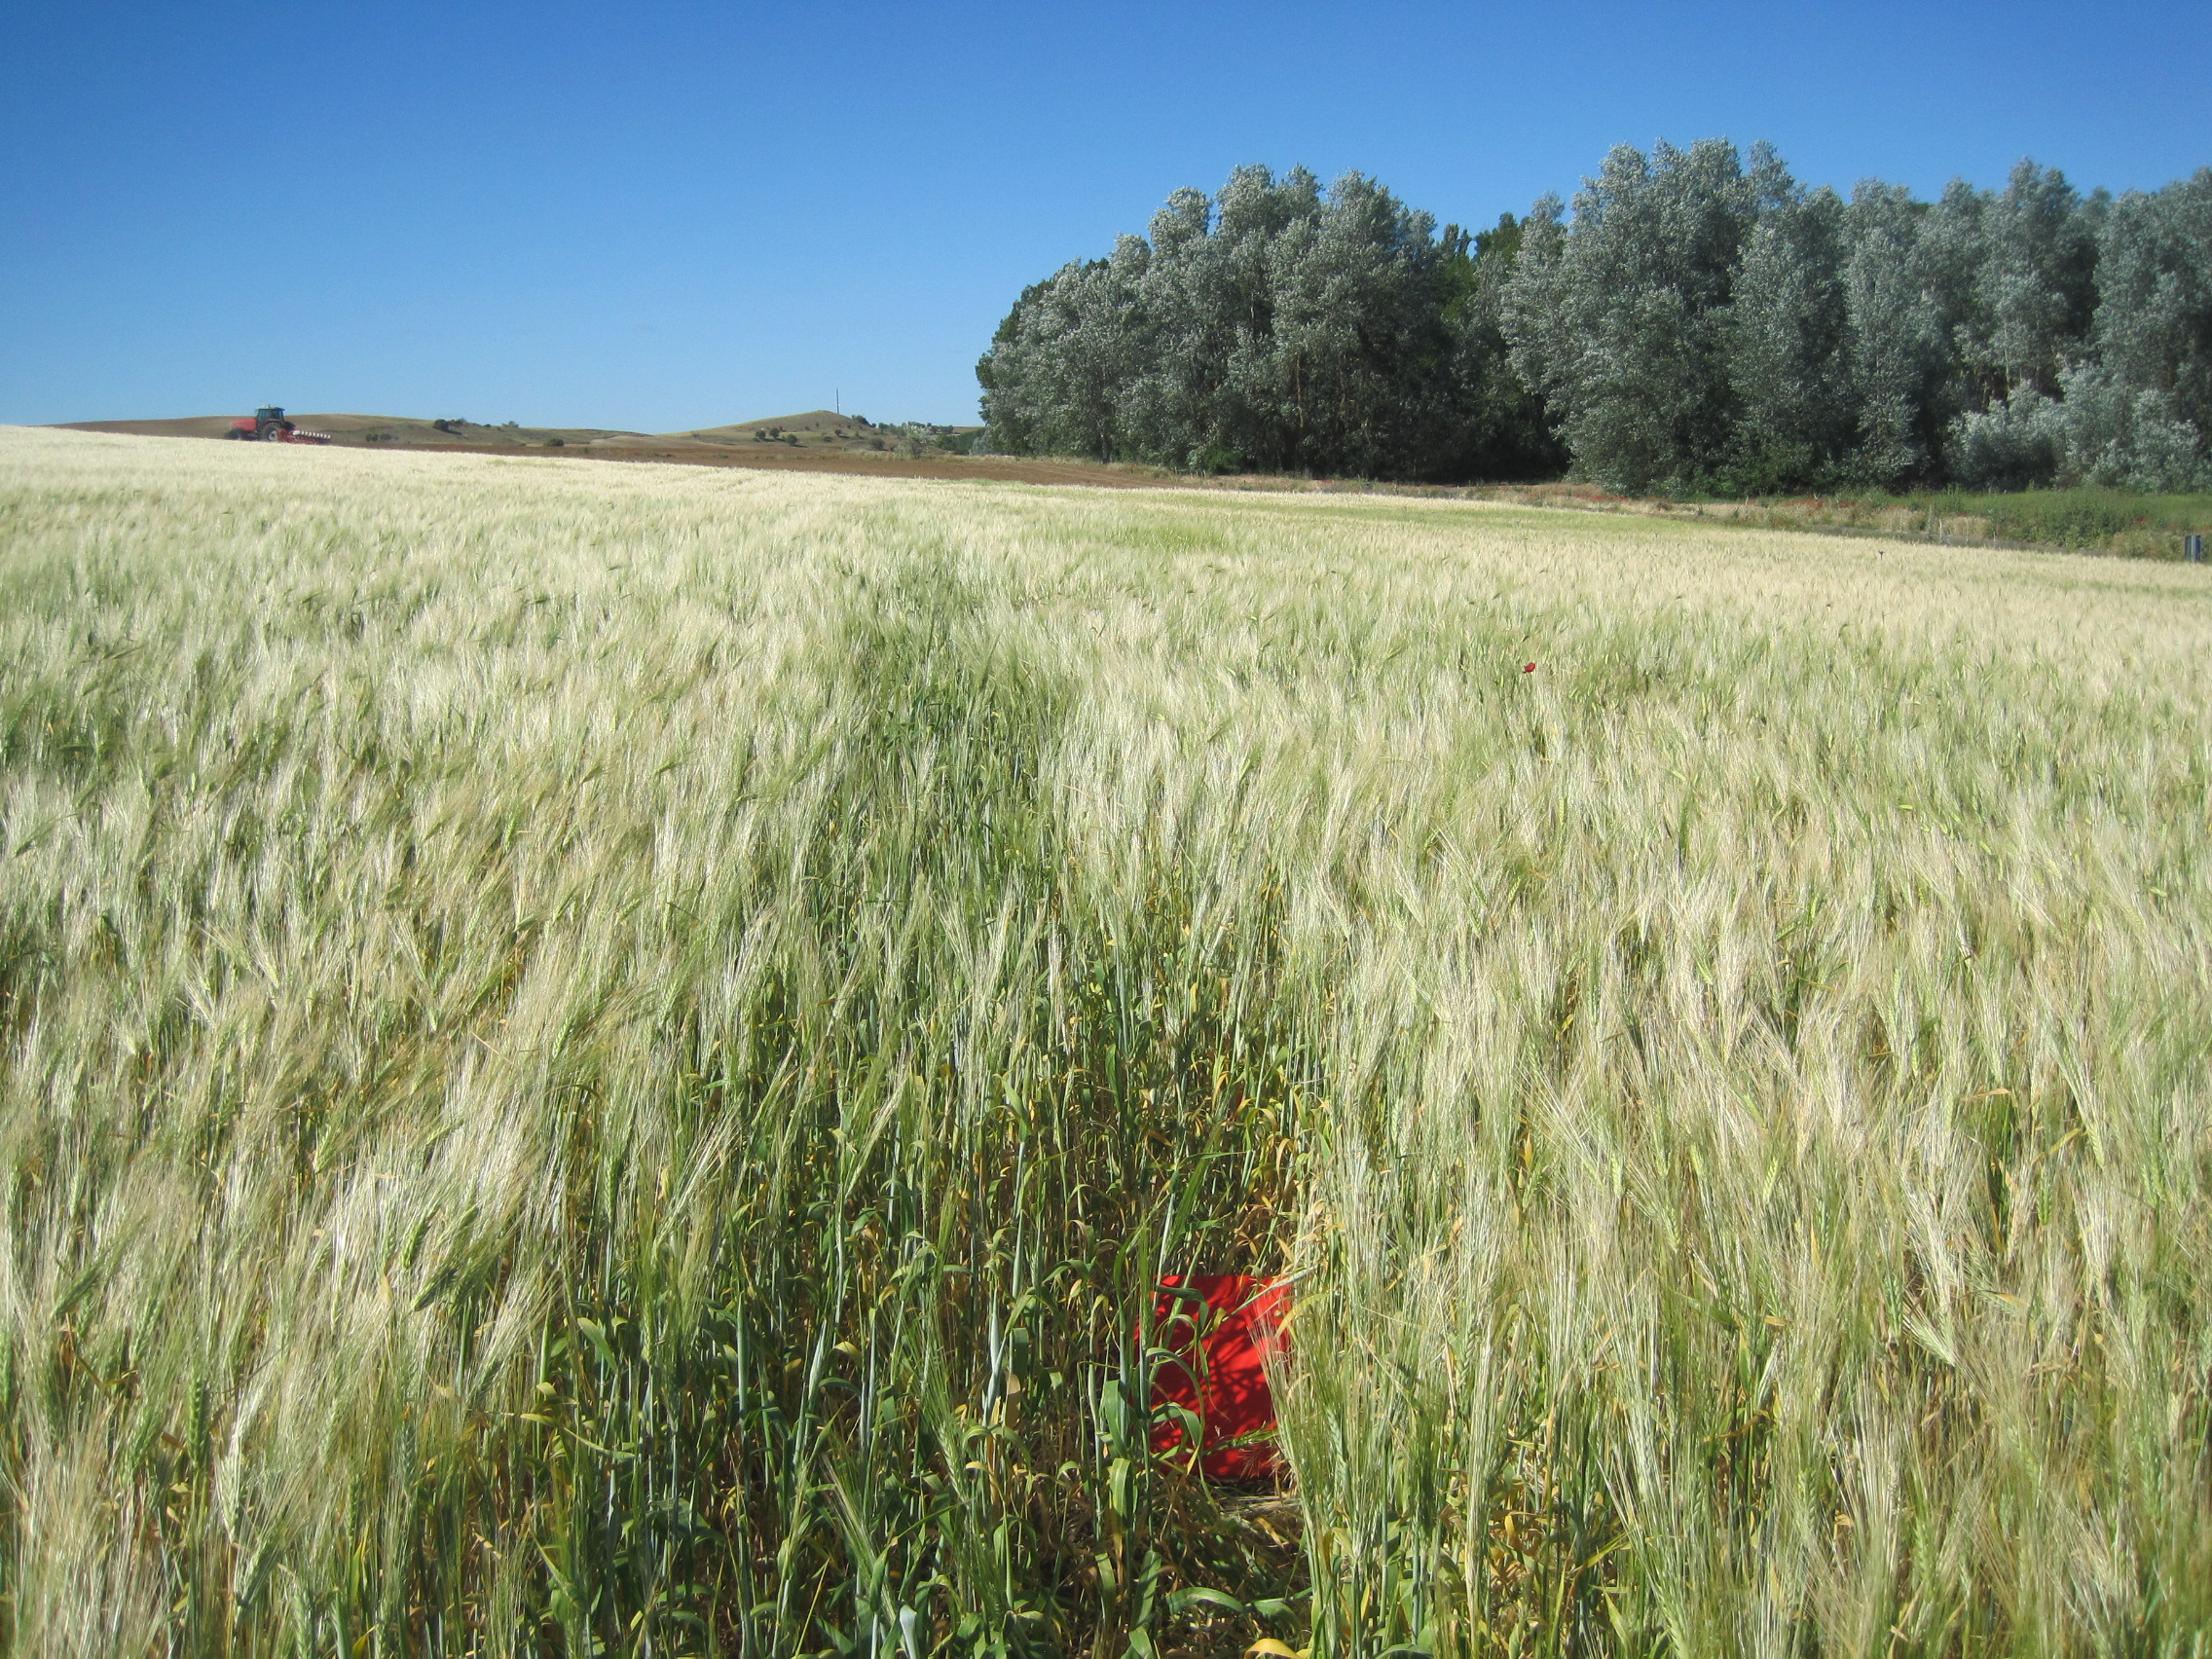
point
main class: Cropland
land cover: Common wheat
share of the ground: > 75 %
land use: Agriculture (excluding fallow land and kitchen gardens)
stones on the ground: < 10 %
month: May
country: ES
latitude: 41.1512
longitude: -5.3134
